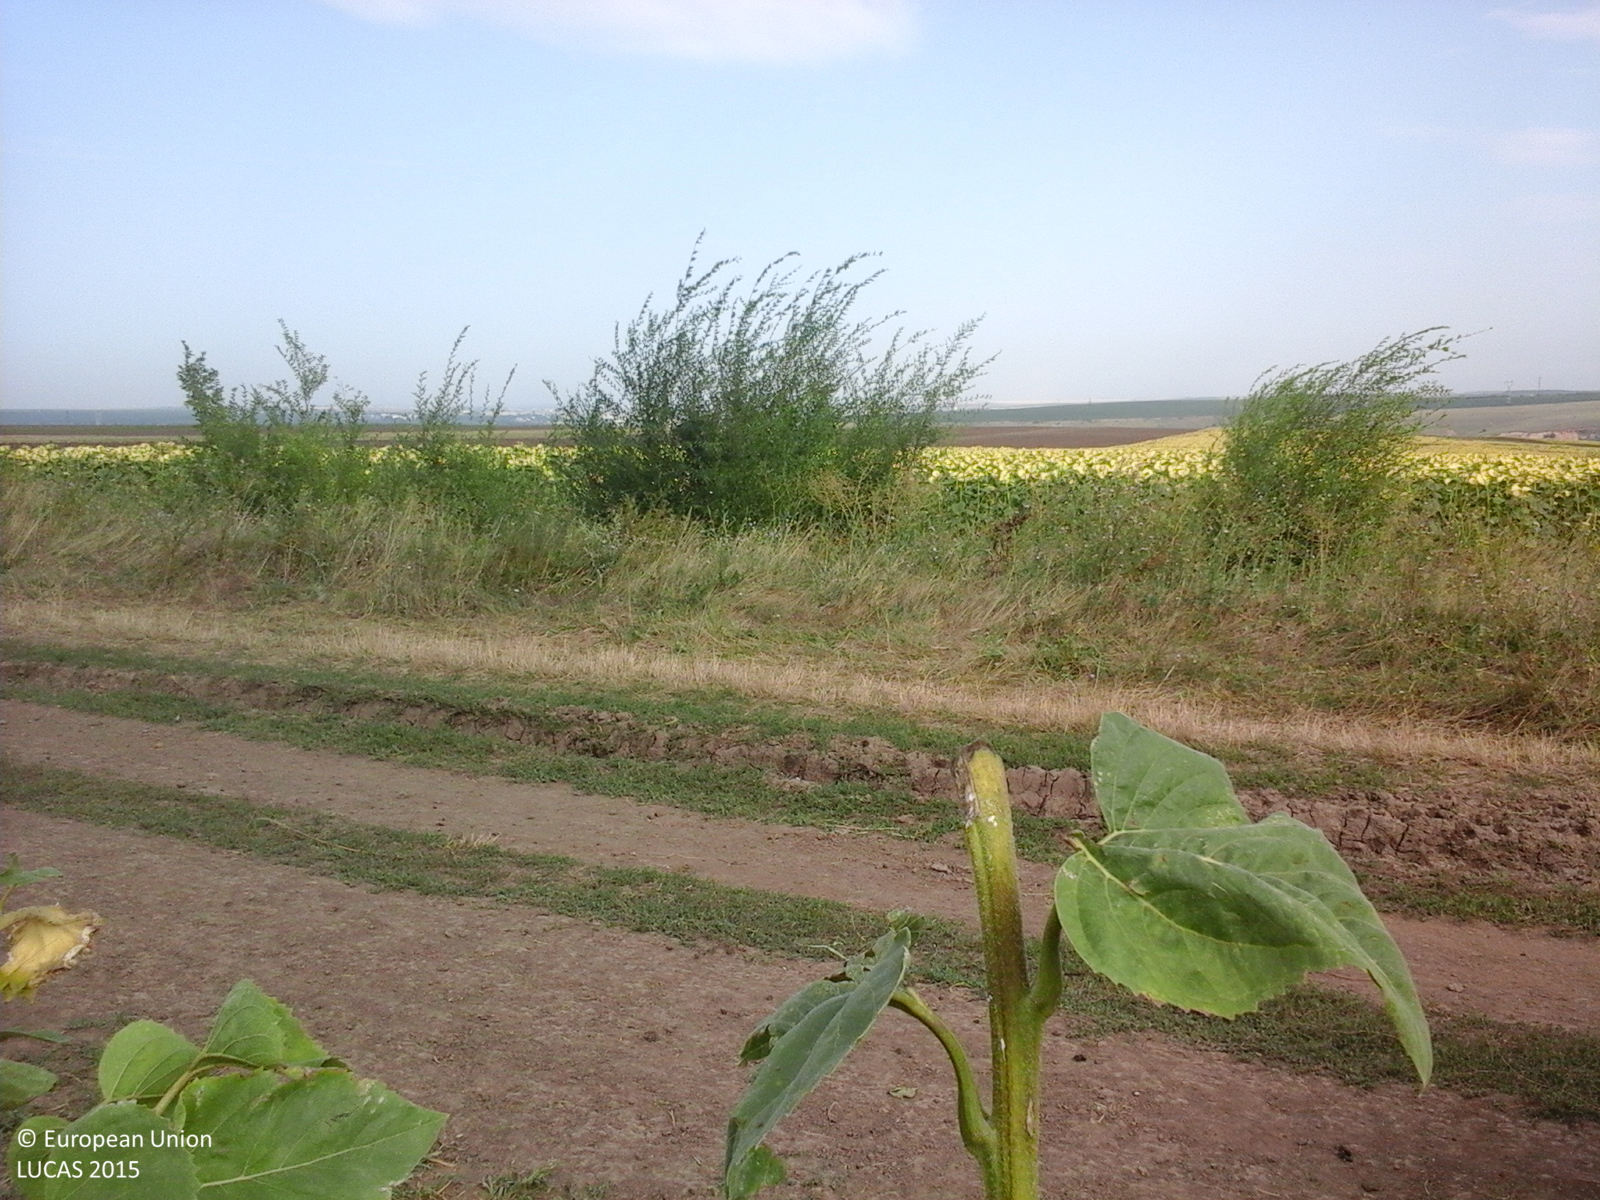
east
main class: Cropland
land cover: Sunflower
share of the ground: > 75 %
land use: Agriculture (excluding fallow land and kitchen gardens)
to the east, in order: Sunflower
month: August
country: RO
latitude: 44.1932
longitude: 28.3442
